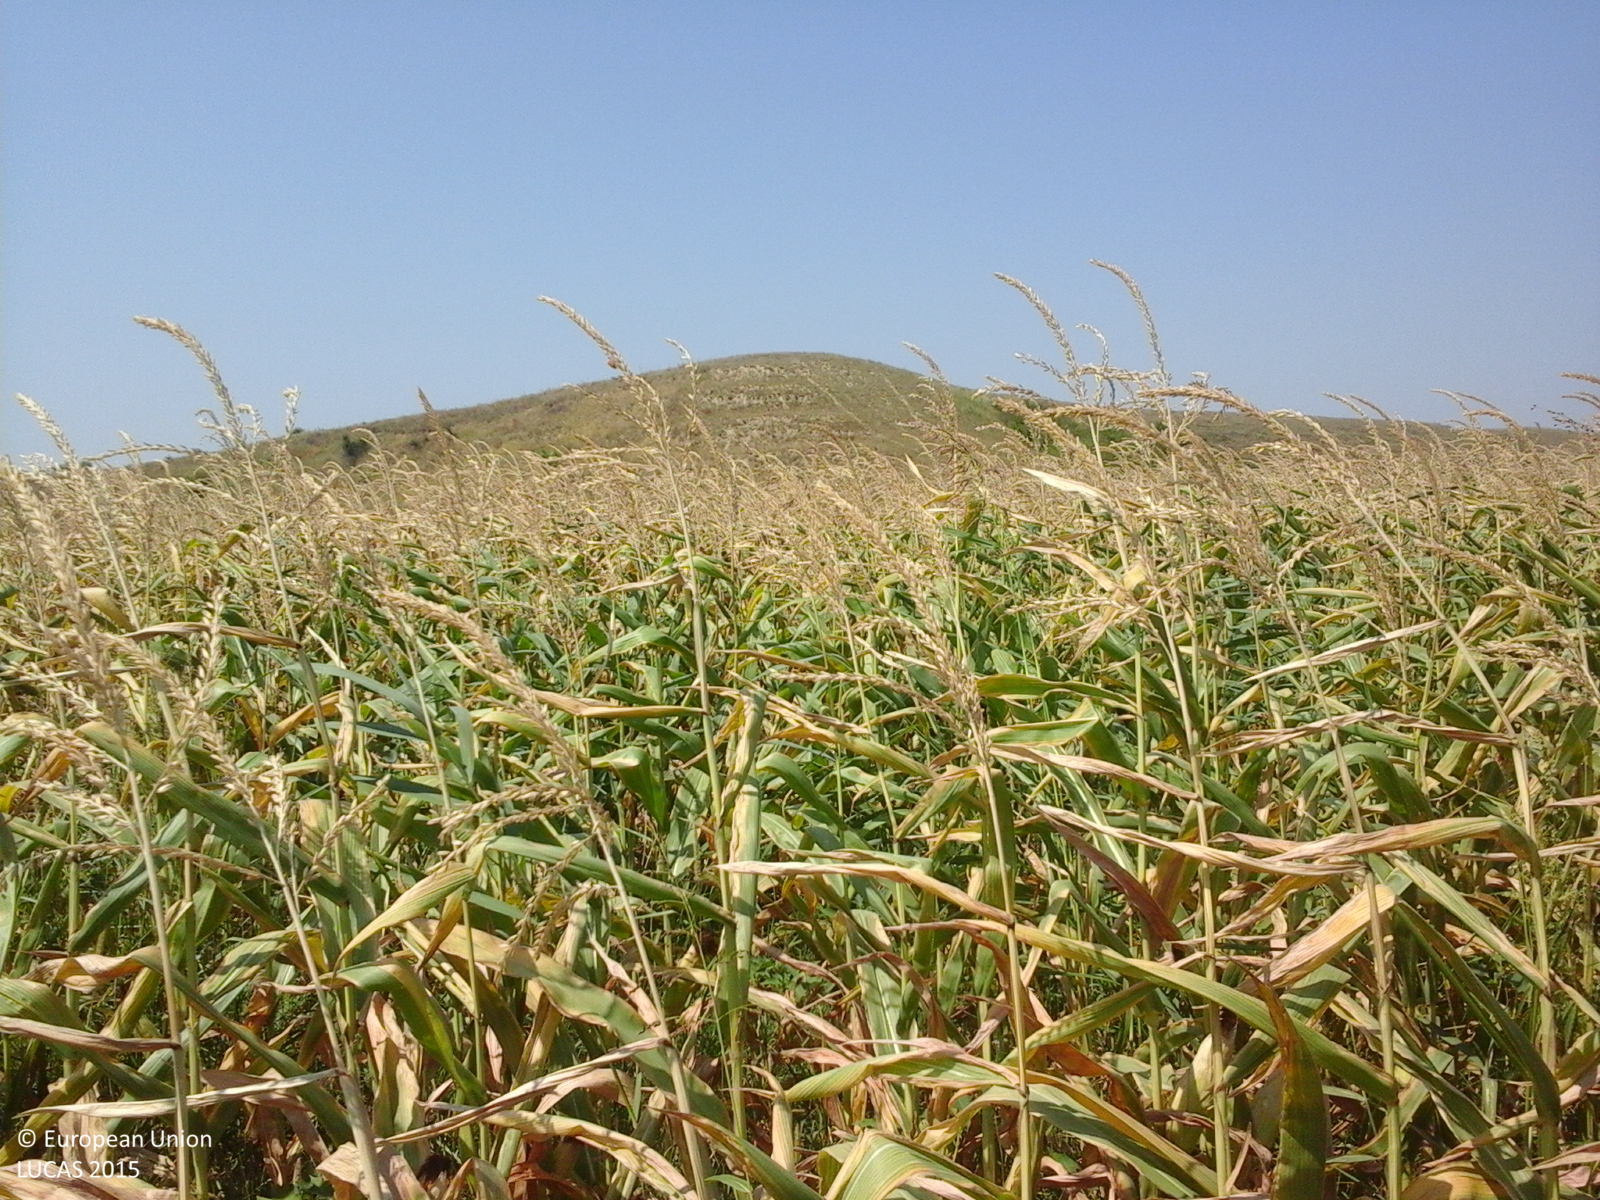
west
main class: Cropland
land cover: Maize
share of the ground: > 75 %
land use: Agriculture (excluding fallow land and kitchen gardens)
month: August
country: RO
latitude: 45.2406
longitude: 27.4100
